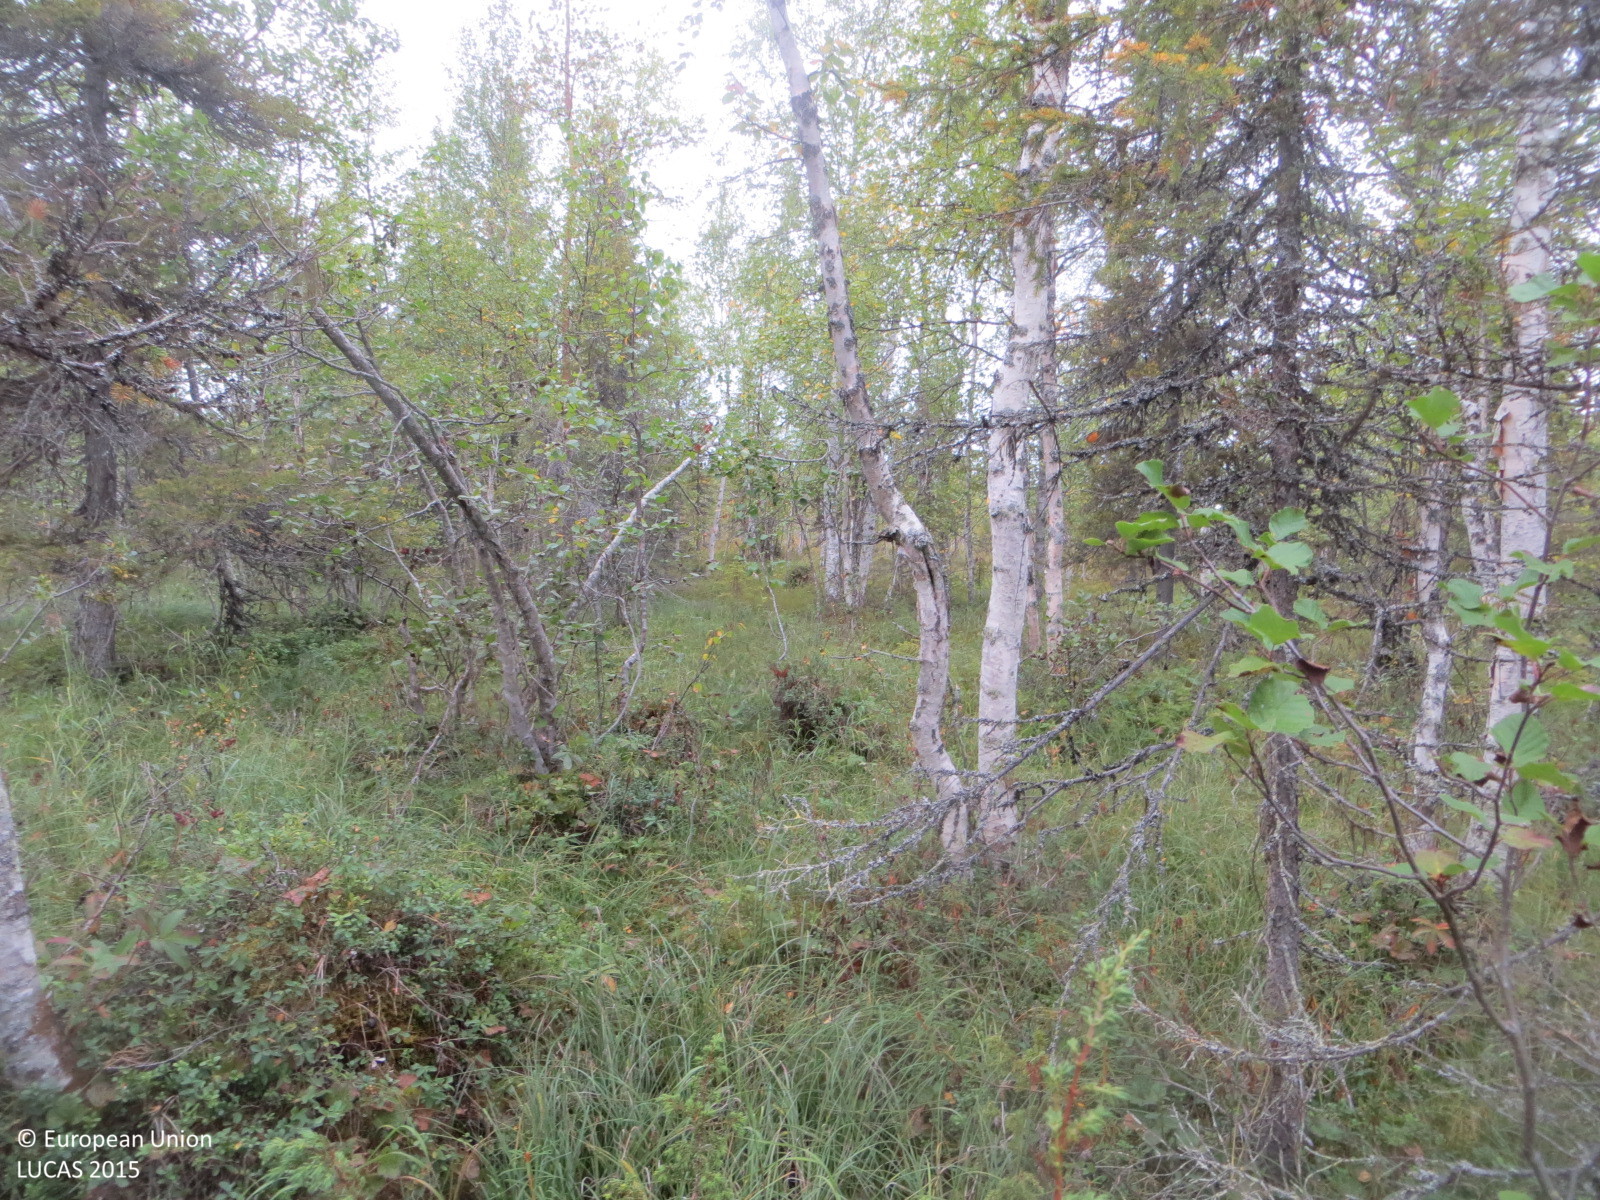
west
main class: Woodland
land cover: Spruce dominated mixed woodland
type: mire and swamp forests
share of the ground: 50 - 75 %
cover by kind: coniferous forest trees 35 %, broadleaved forest trees 35 %, herbaceous plants 20 %, shrubs 10 %
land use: Forestry
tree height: > 5 m
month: August
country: FI
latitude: 67.4978
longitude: 24.2390
